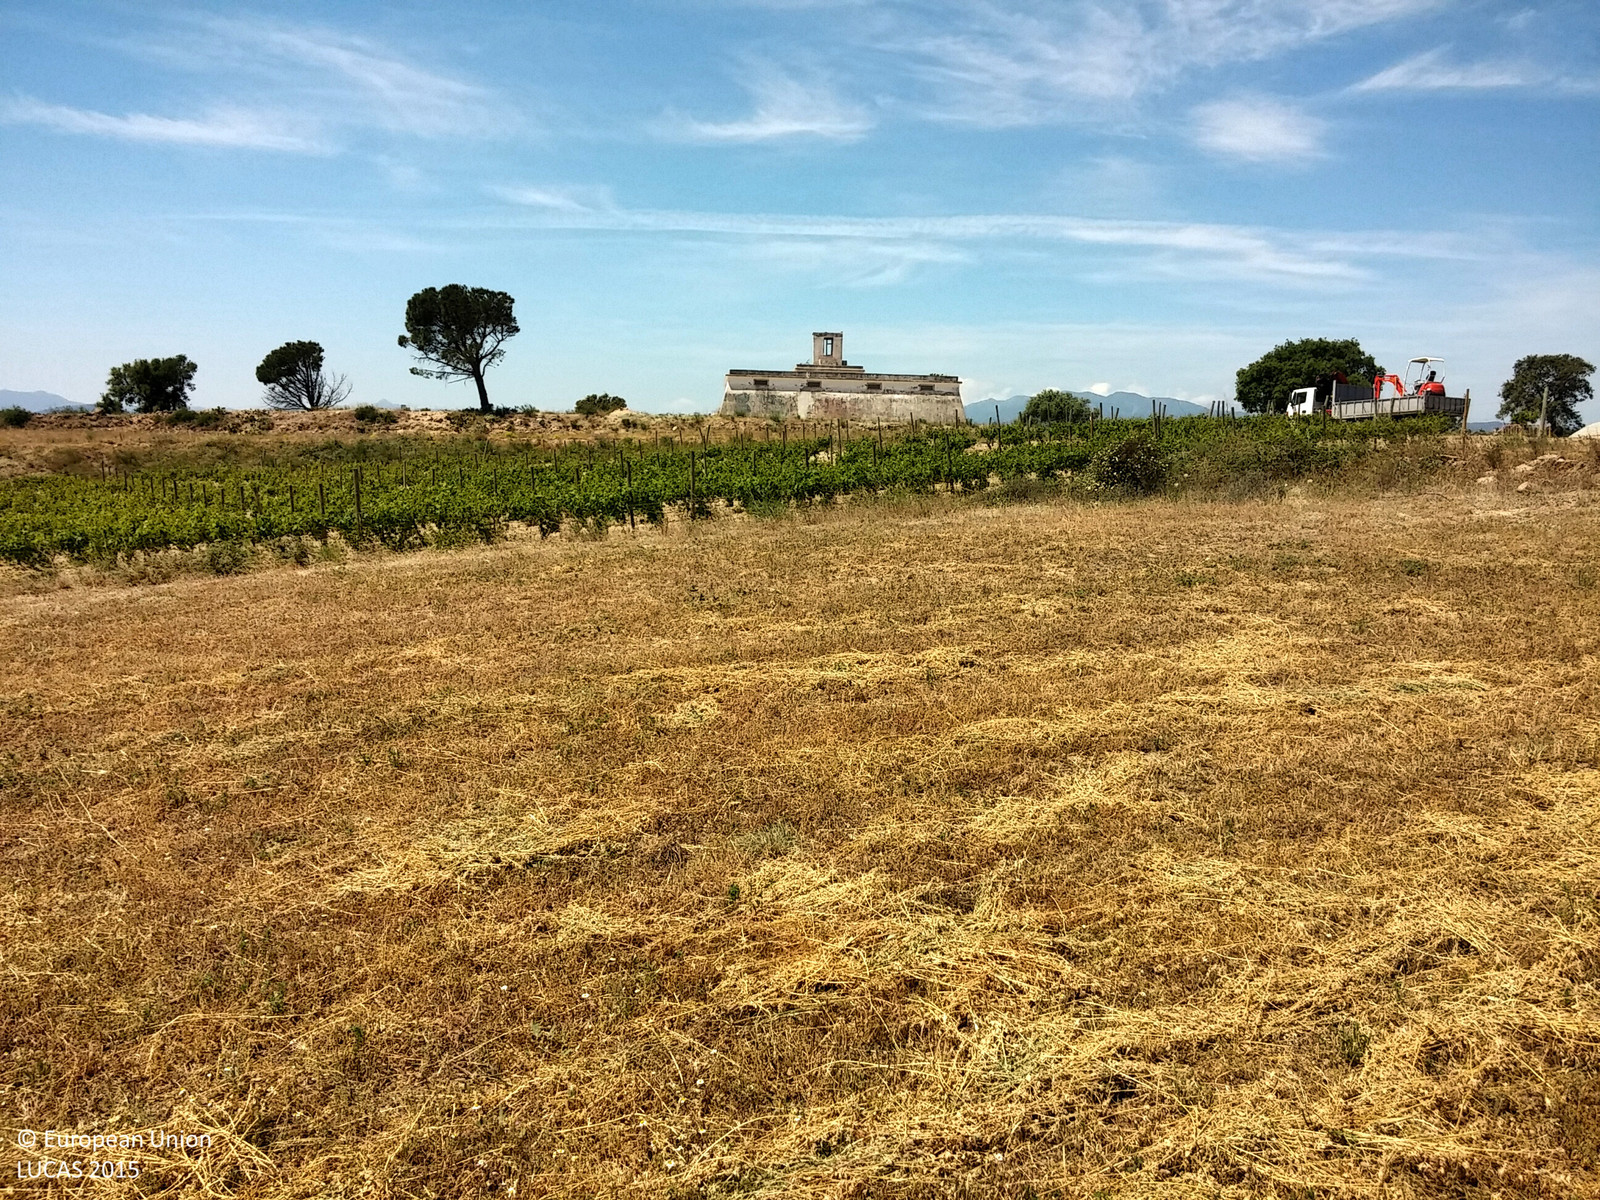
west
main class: Cropland
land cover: Lucerne
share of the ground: > 75 %
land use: Agriculture (excluding fallow land and kitchen gardens)
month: May
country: ES
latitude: 42.3742
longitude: 2.9822
